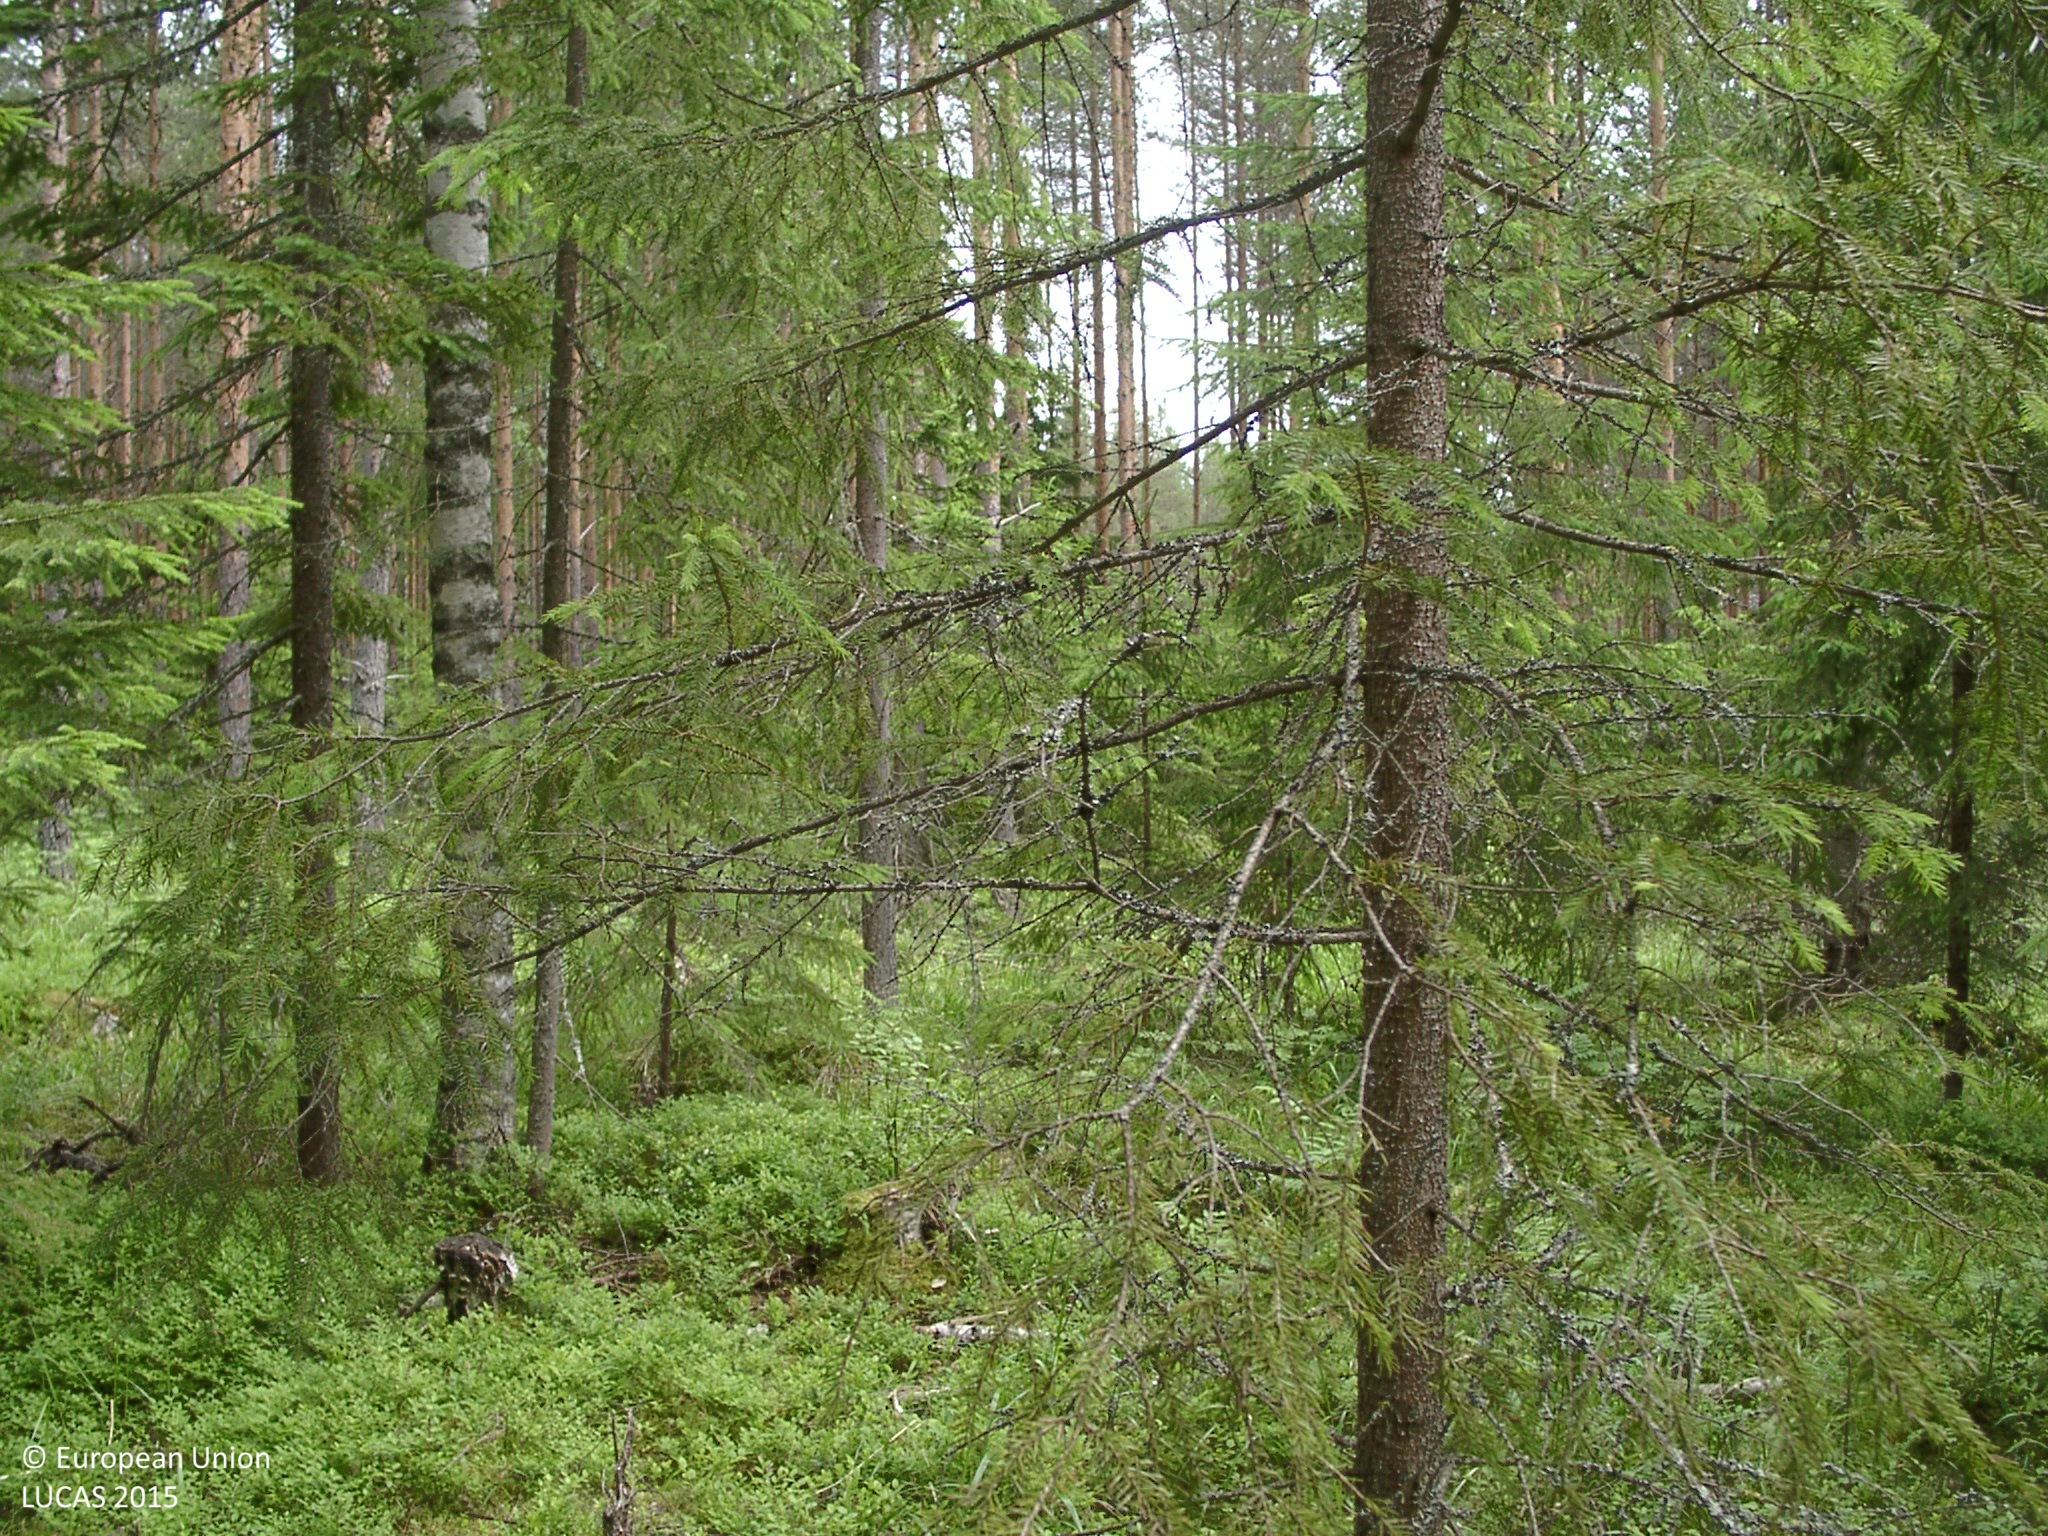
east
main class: Woodland
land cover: Spruce dominated mixed woodland
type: boreal forest
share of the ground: 50 - 75 %
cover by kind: coniferous forest trees 45 %, shrubs 25 %, broadleaved forest trees 15 %, herbaceous plants 10 %, lichens and mosses 5 %
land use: Semi-natural and natural areas not in use
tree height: > 5 m
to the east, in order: Spruce dominated mixed woodland; Shruby margins; Pine dominated coniferous woodland; Broadleaved woodland; Ditches and canals; Pine dominated coniferous woodland; Shruby margins; Pine dominated mixed woodland; Shruby margins; Pine dominated coniferous woodland; Shruby margins; Pine dominated coniferous woodland; Shruby margins; Pine dominated coniferous woodland
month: June
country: FI
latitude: 62.0793
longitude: 24.7826
